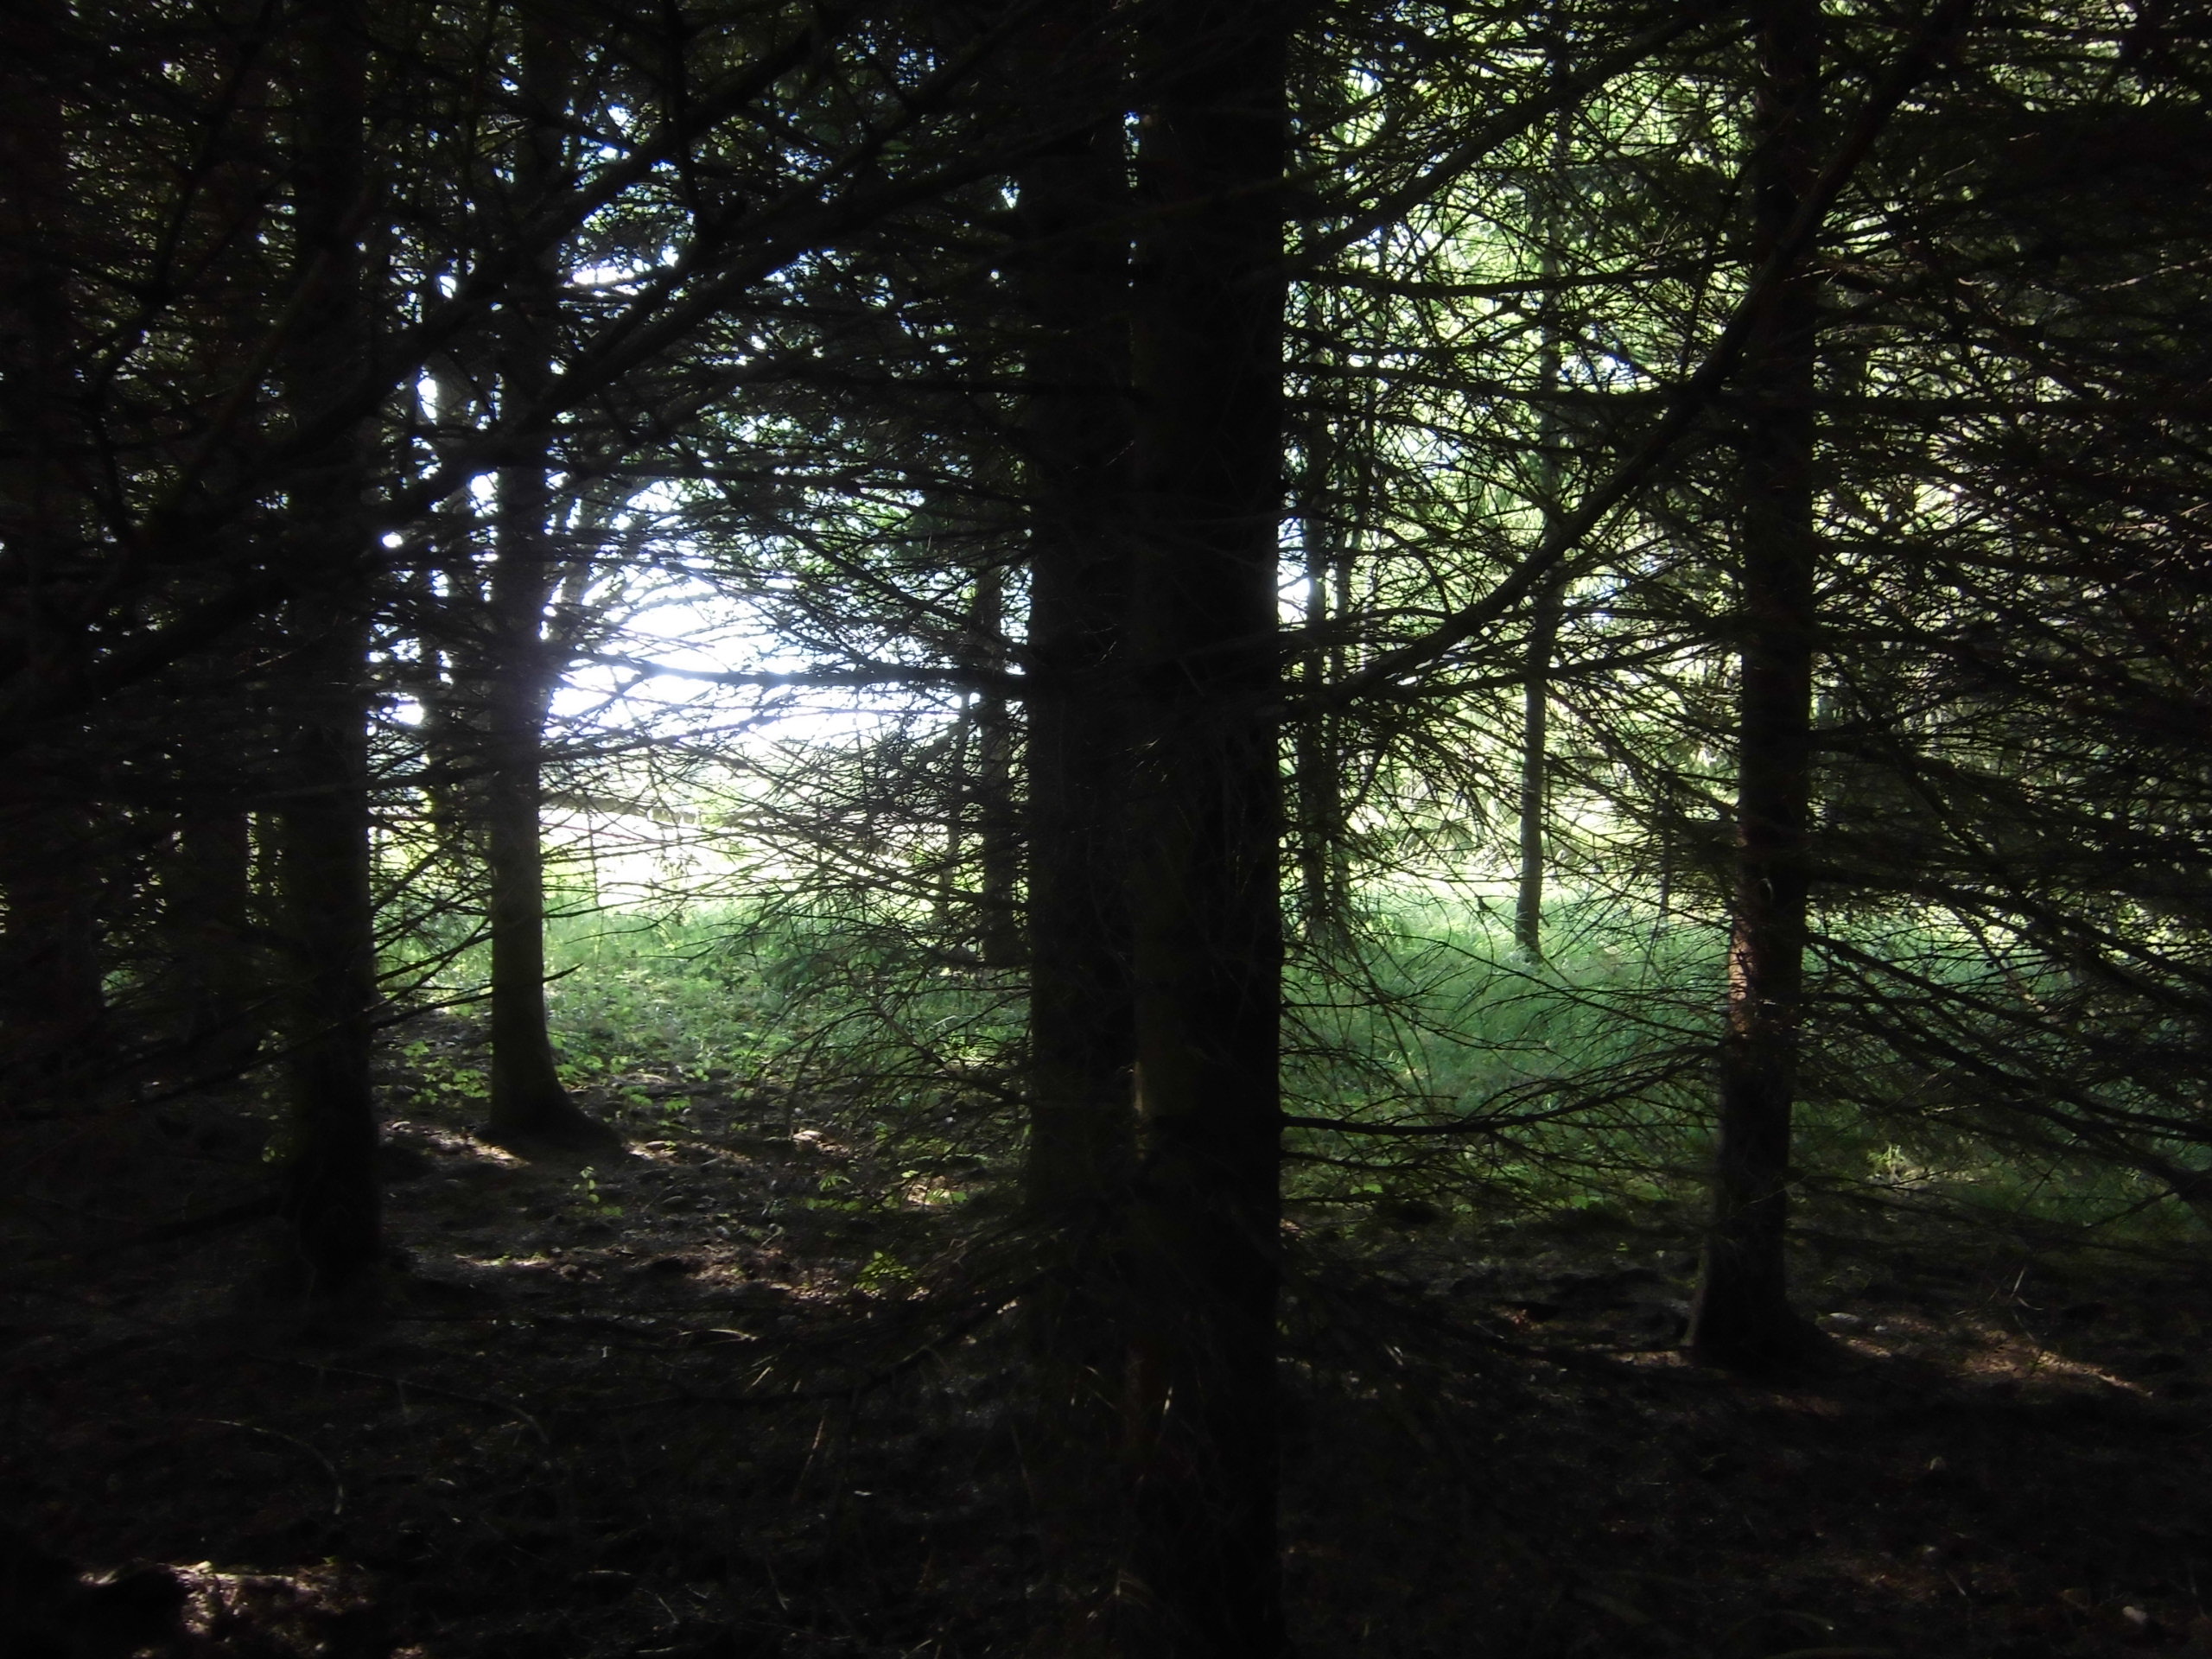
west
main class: Woodland
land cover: Spruce dominated coniferous woodland
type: boreal forest
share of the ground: > 75 %
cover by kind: coniferous forest trees 80 %, unconsolidated bare surface 15 %, herbaceous plants 5 %
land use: Forestry
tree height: > 5 m
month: July
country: SE
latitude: 57.1608
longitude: 15.2716
